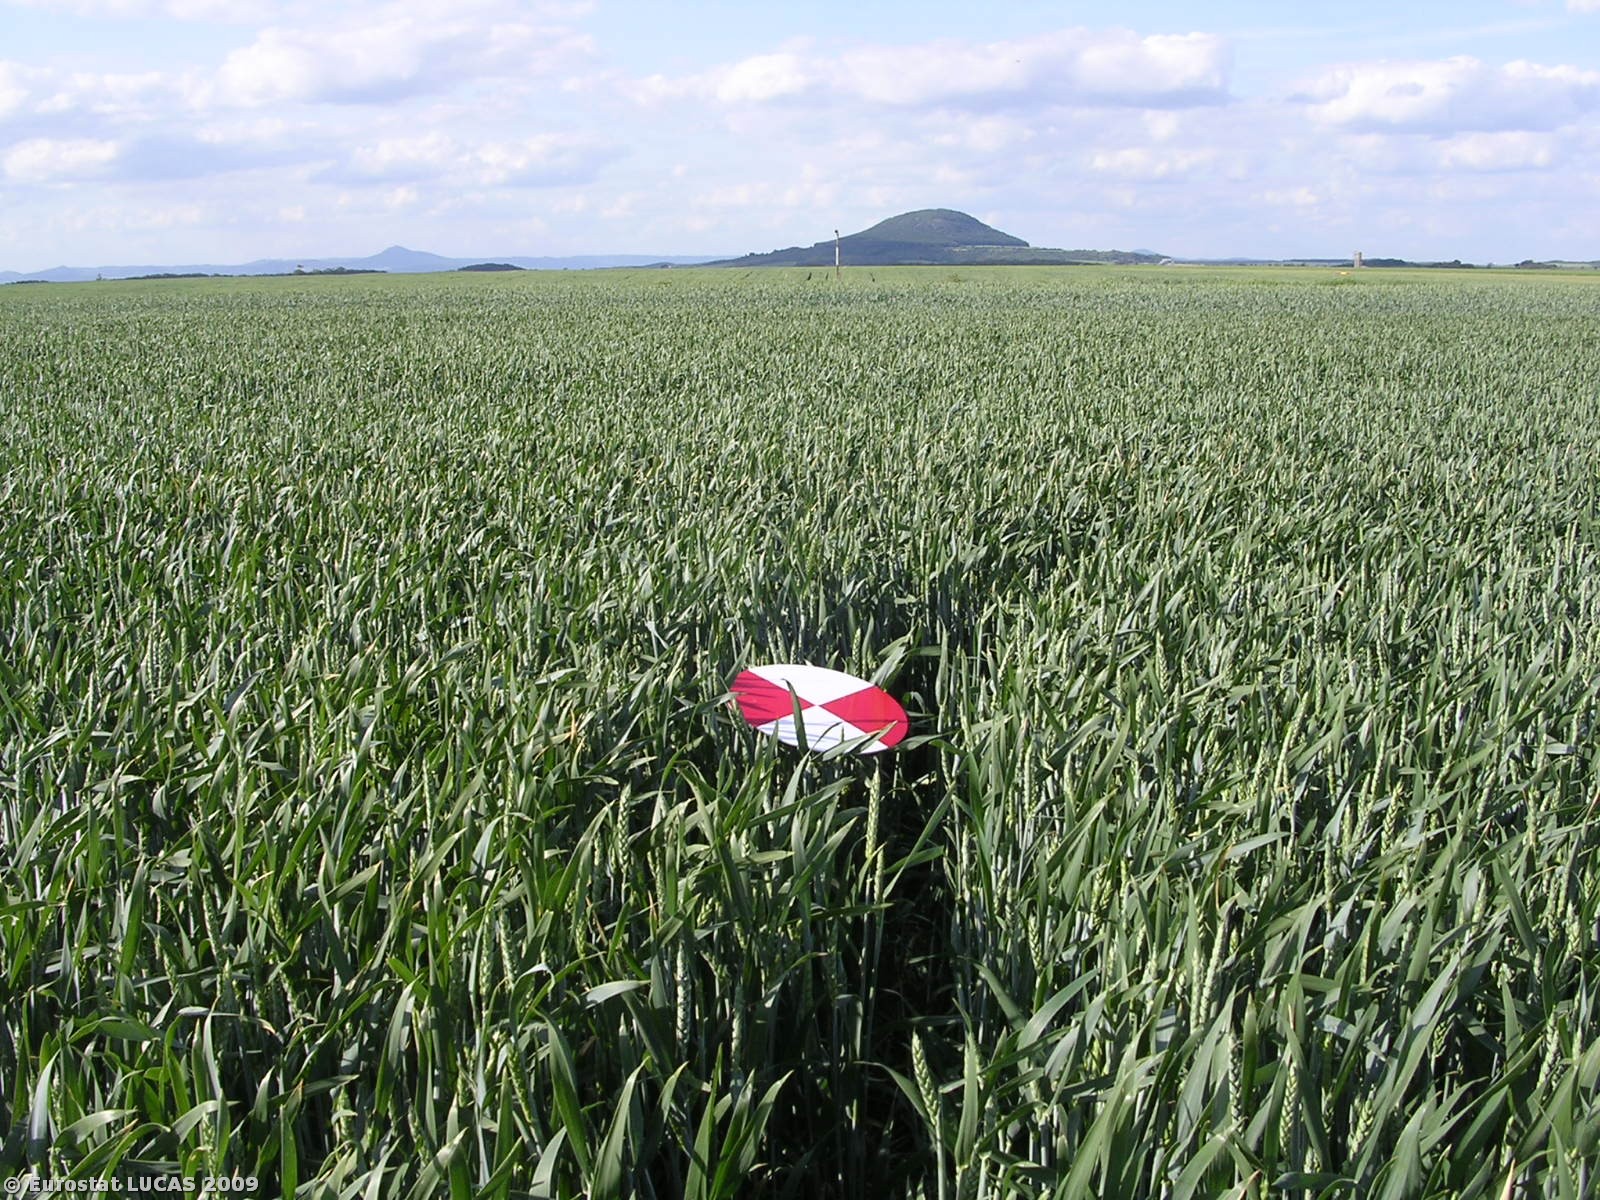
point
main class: Cropland
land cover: Common wheat
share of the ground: > 75 %
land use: Agriculture (excluding fallow land and kitchen gardens)
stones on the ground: < 10 %
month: May
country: CZ
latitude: 50.3209
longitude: 14.2570
